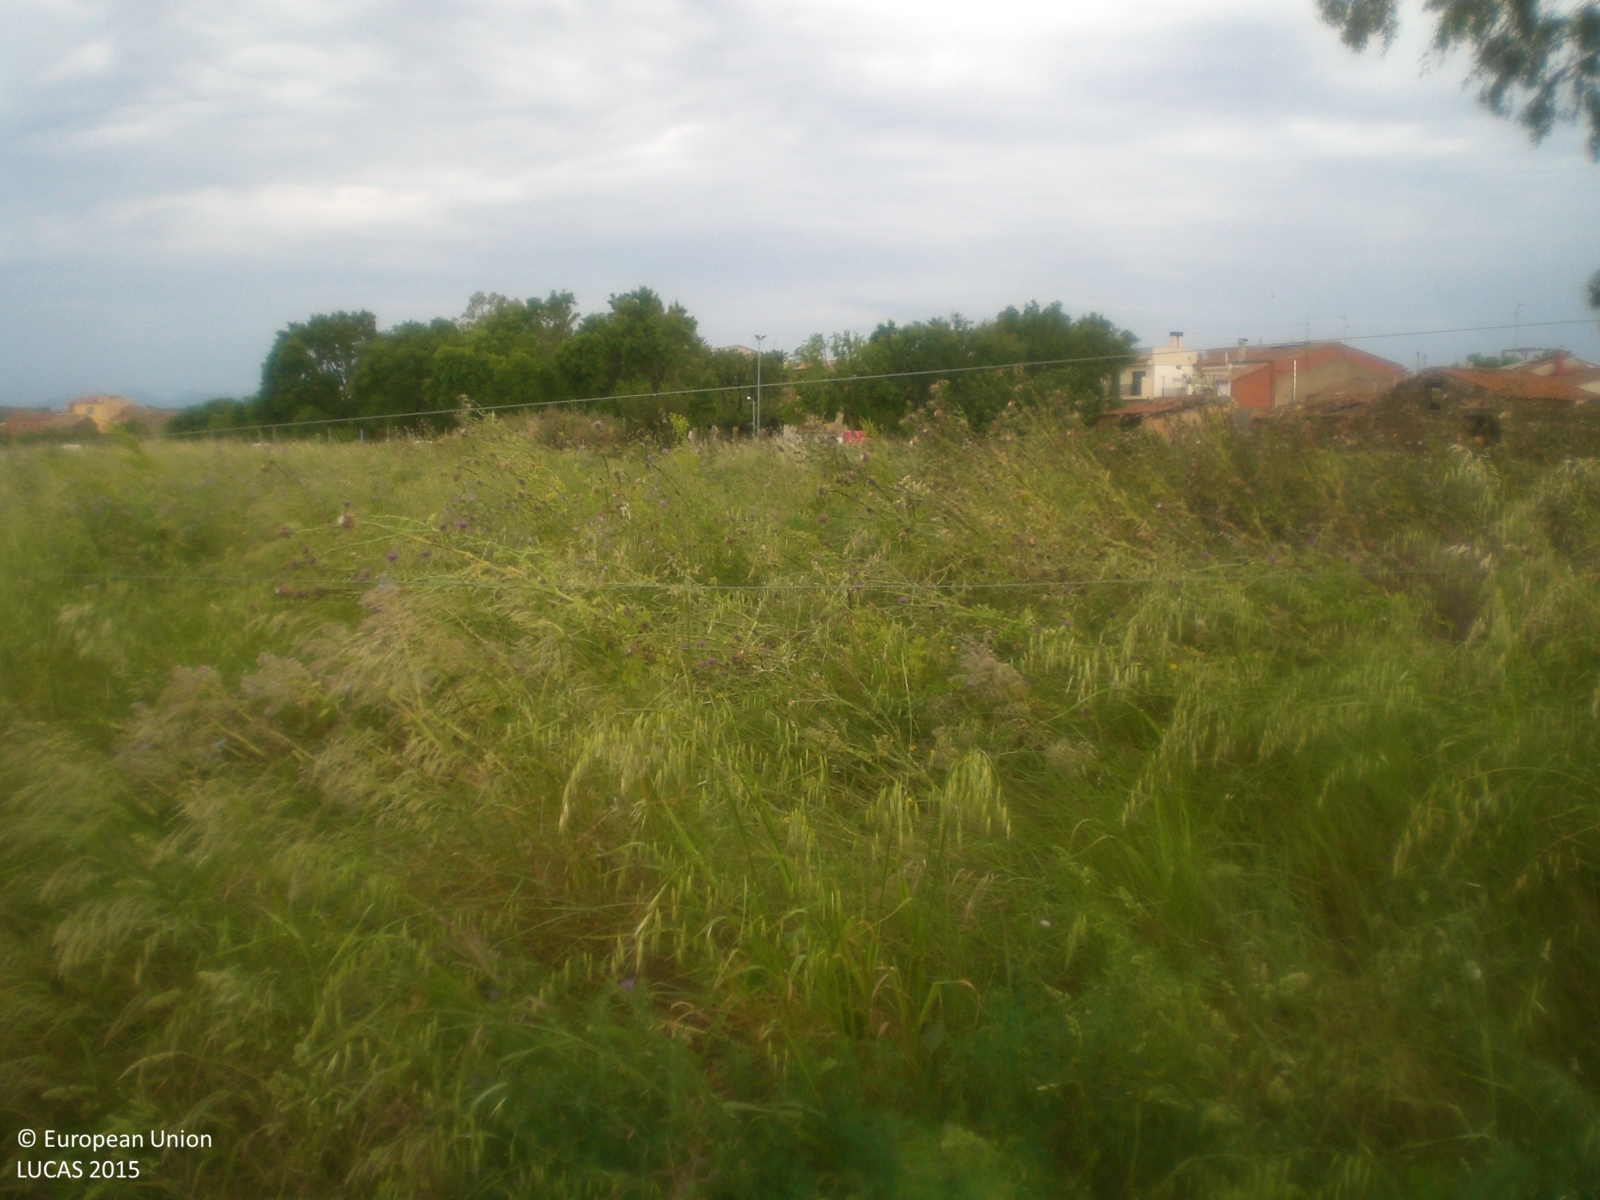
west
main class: Grassland
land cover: Grassland without tree/shrub cover
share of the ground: > 75 %
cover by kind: herbaceous plants 90 %, consolidated bare surface 10 %
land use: Abandoned areas
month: May
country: ES
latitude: 42.3432
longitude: 3.0587
